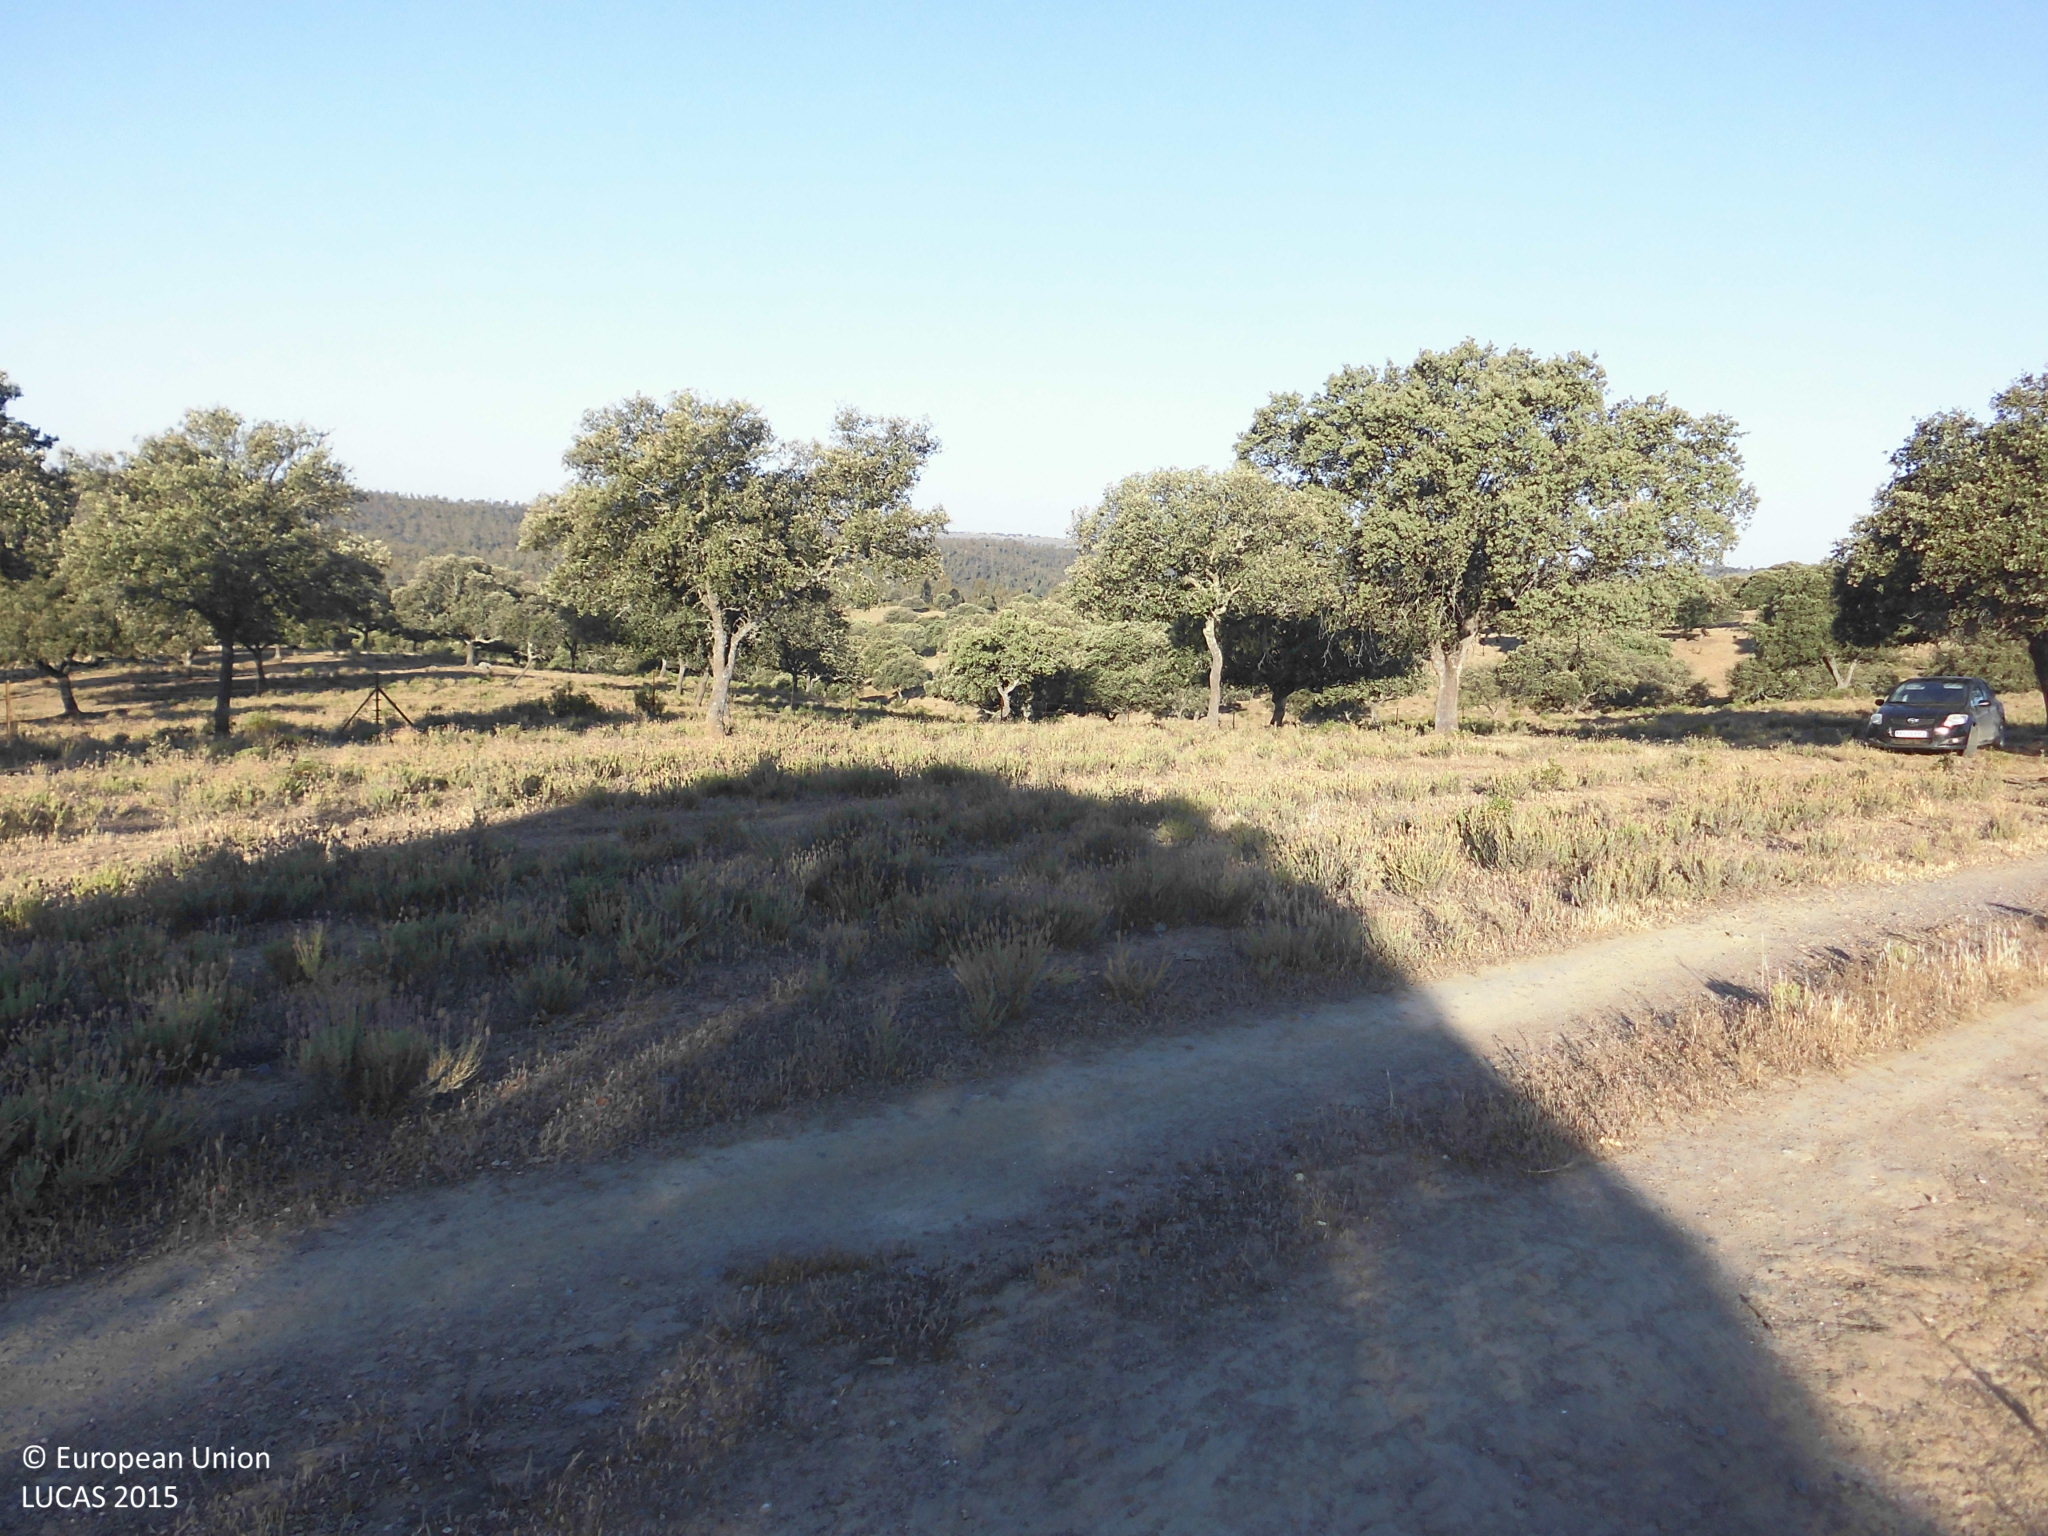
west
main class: Woodland
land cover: Broadleaved woodland
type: broadleaved evergreen forest
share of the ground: 10 - 25 %
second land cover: Grassland without tree/shrub cover
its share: > 75 %
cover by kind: herbaceous plants 80 %, broadleaved forest trees 15 %, consolidated bare surface 5 %
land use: Forestry
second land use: Agriculture (excluding fallow land and kitchen gardens)
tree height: > 5 m
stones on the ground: 10 - 25 %
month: May
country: ES
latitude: 39.7749
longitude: -6.9560
